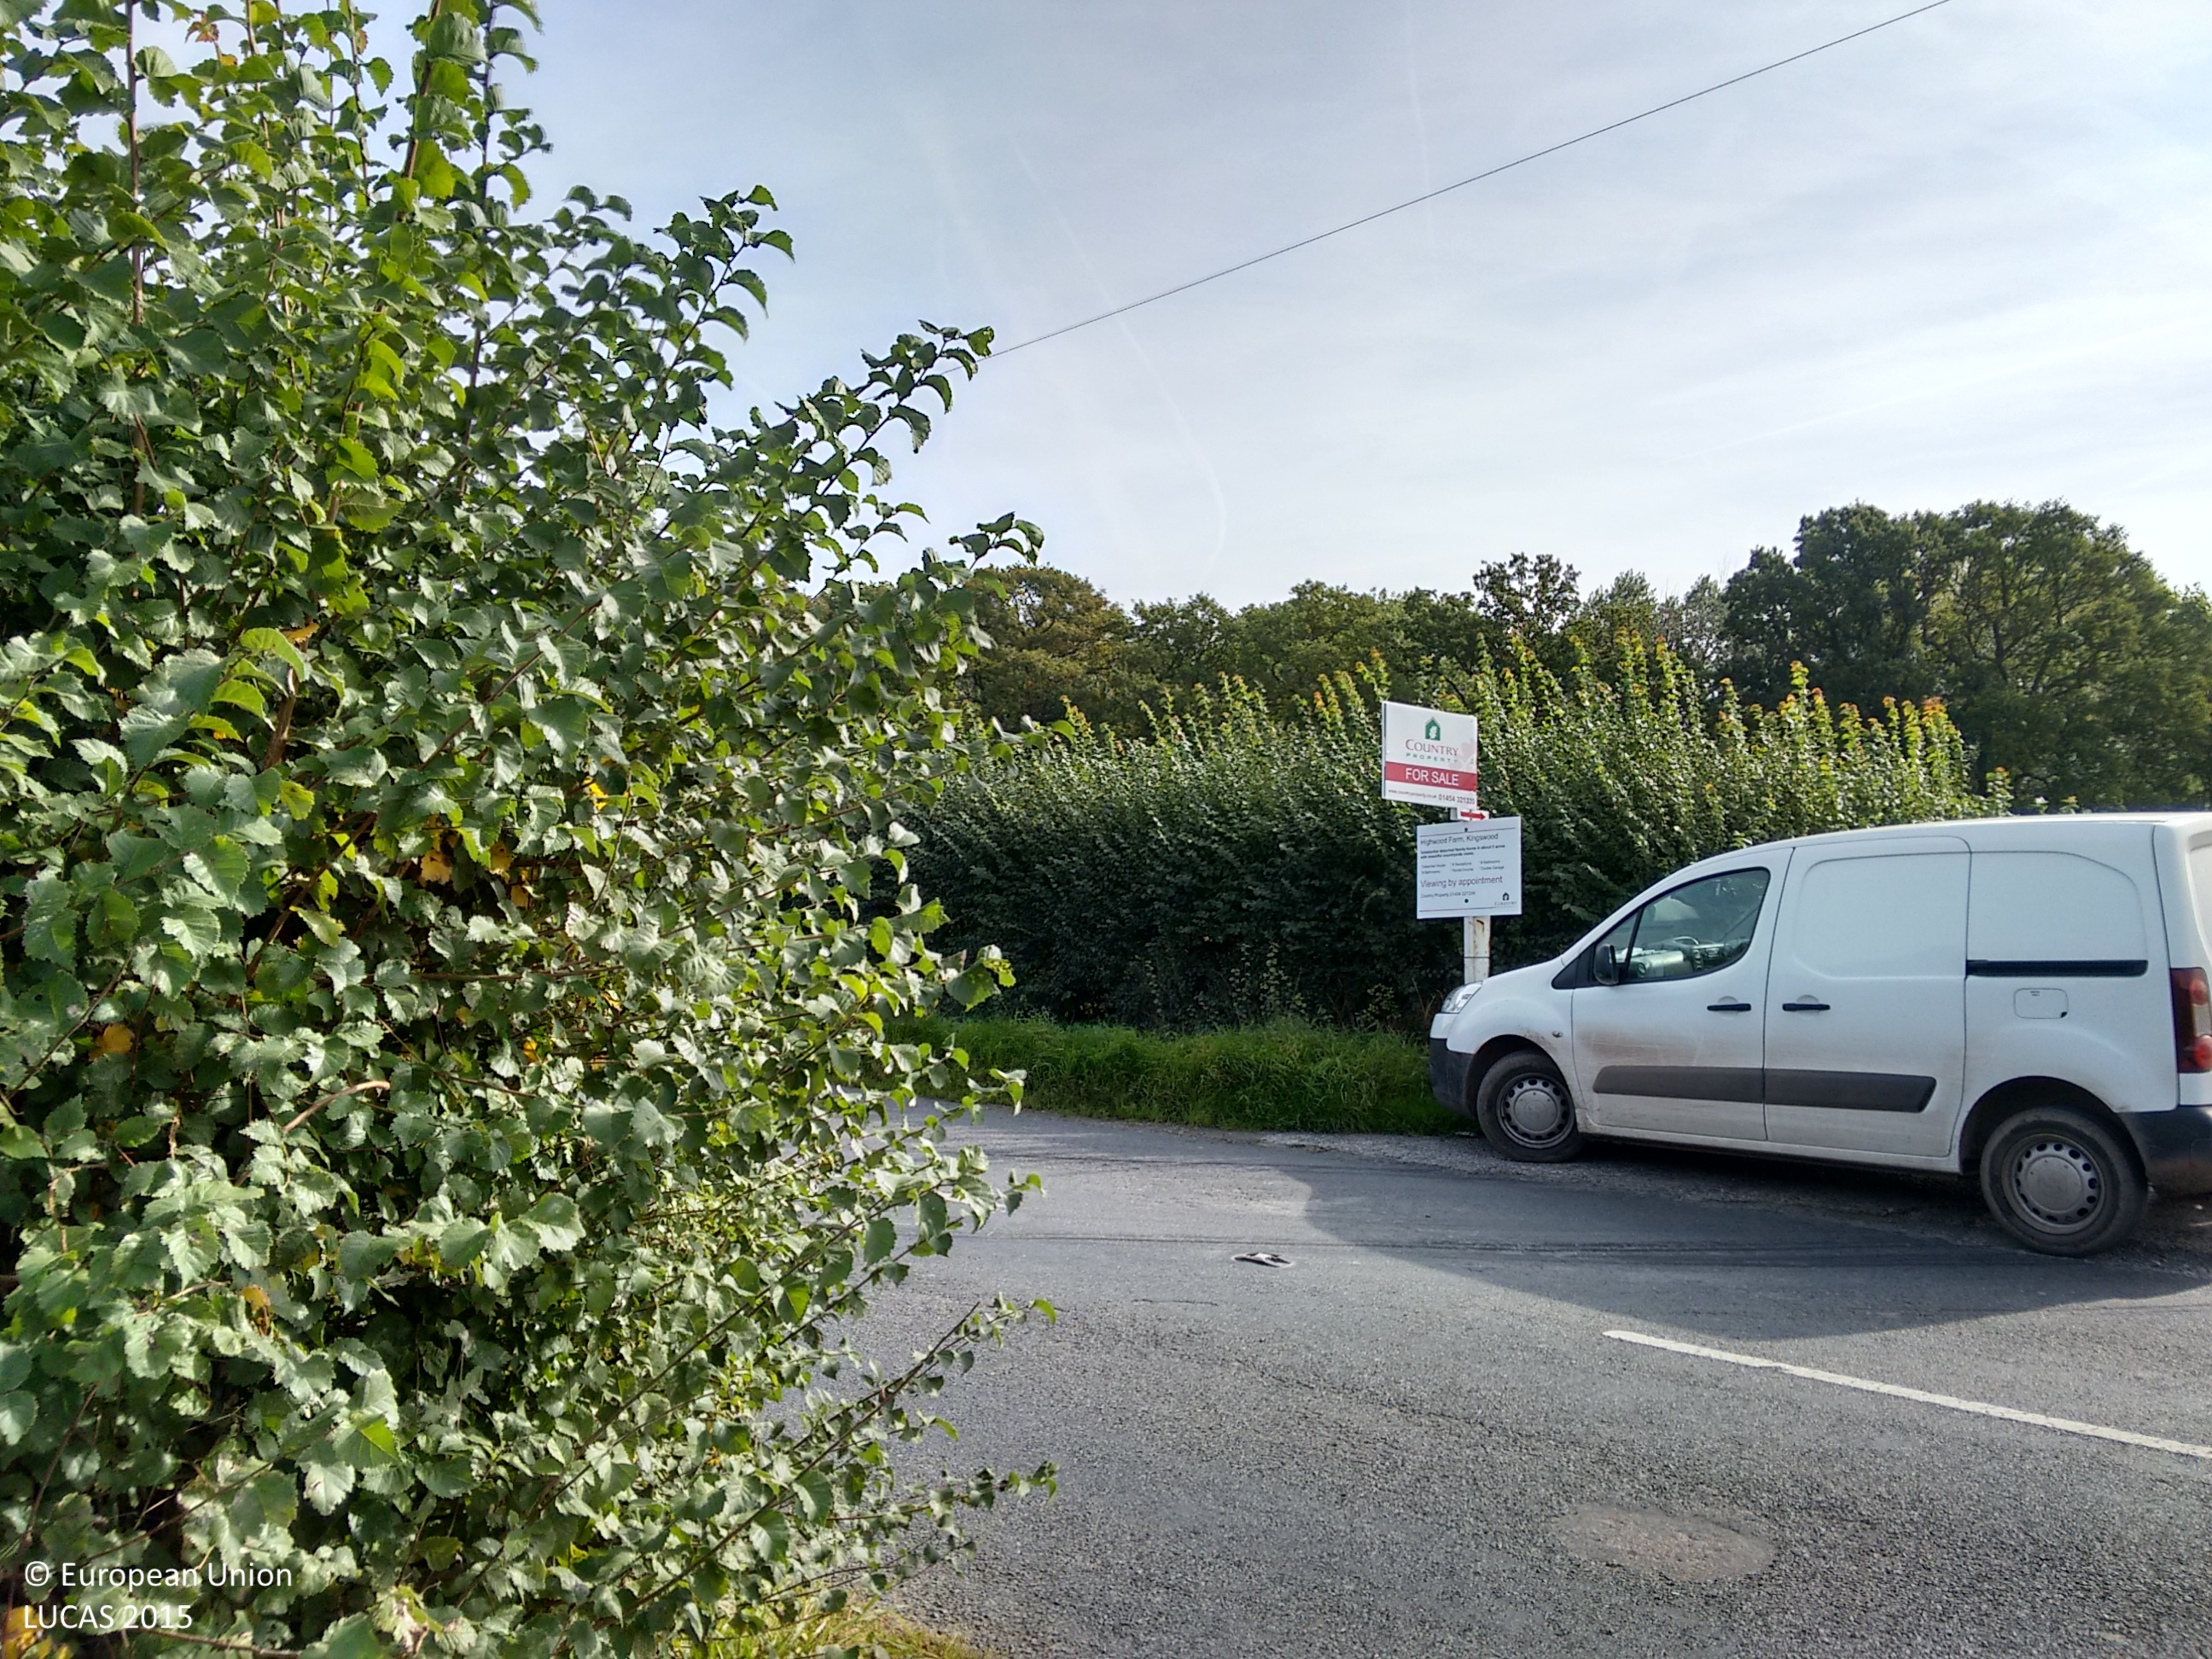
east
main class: Grassland
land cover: Grassland without tree/shrub cover
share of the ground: > 75 %
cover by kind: herbaceous plants 100 %
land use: Agriculture (excluding fallow land and kitchen gardens)
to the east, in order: Grassland without tree/shrub cover; Electric lines; Grassland without tree/shrub cover; Fences; Managed hedges; Grassland without tree/shrub cover; Lines of trees; Tracks; Lines of trees; Grassland without tree/shrub cover; Fences; Managed hedges; Shruby margins; Ditches and canals; Grass margins; Paved roads, cycling and walking lanes; Fences; Electric lines; Managed hedges; Artificial constructions in urban areas
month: September
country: GB
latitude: 51.6167
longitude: -2.3840
